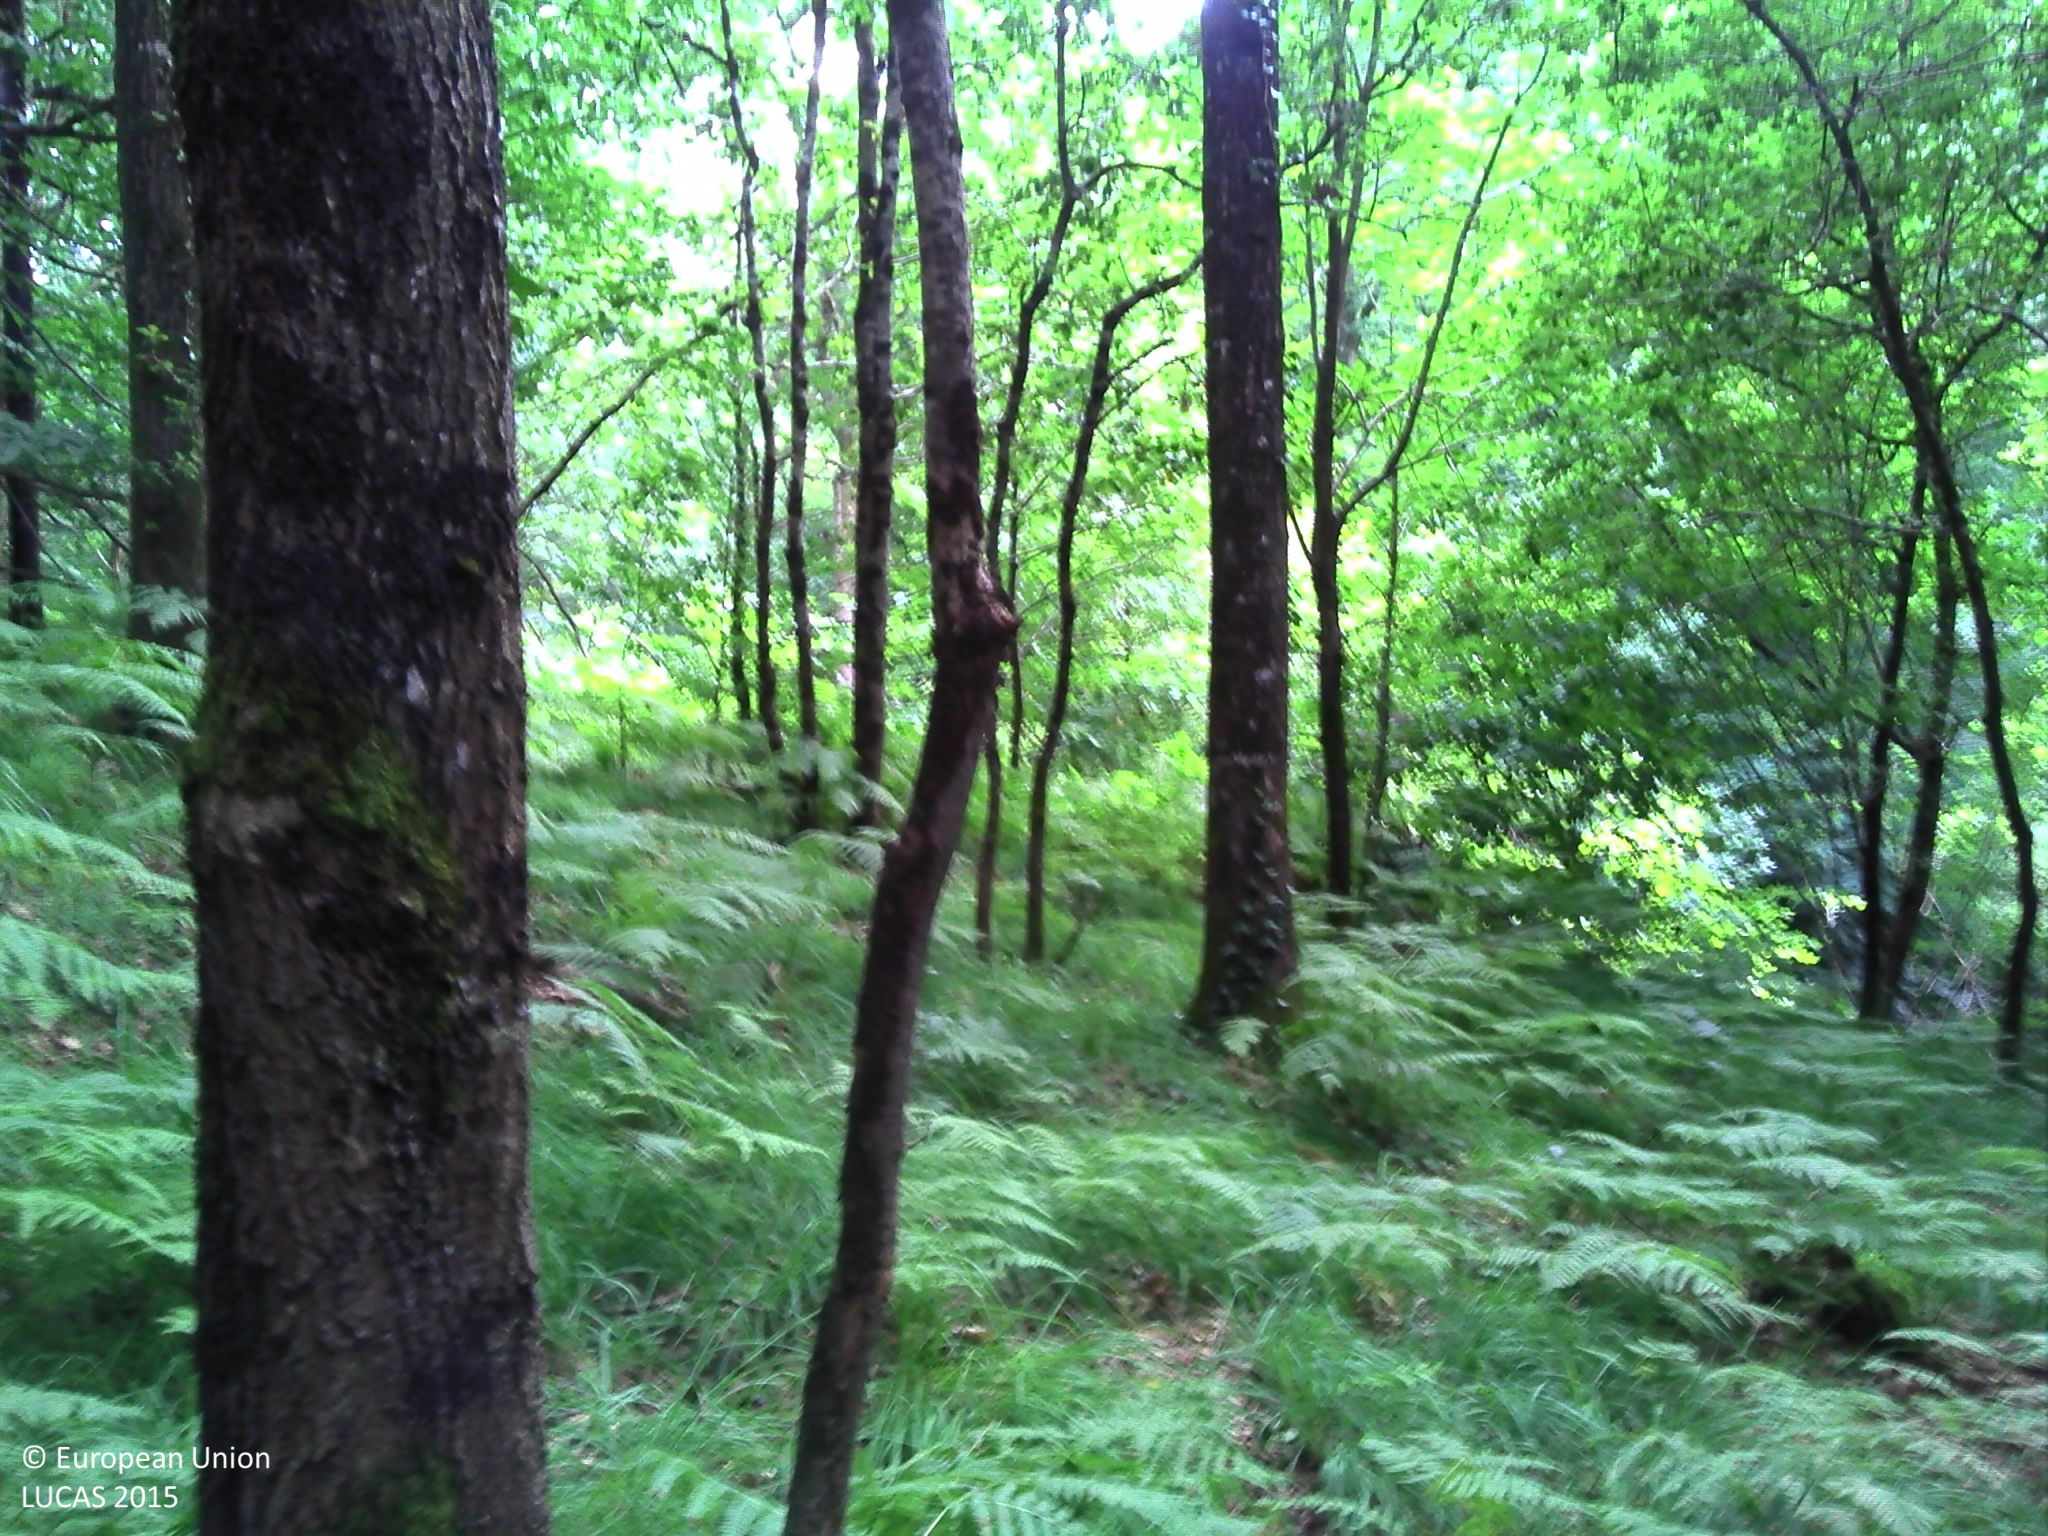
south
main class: Woodland
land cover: Broadleaved woodland
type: mesophytic deciduous forest
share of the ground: > 75 %
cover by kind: broadleaved forest trees 100 %
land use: Forestry
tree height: > 5 m
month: August
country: FR
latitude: 48.7016
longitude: -1.2268
